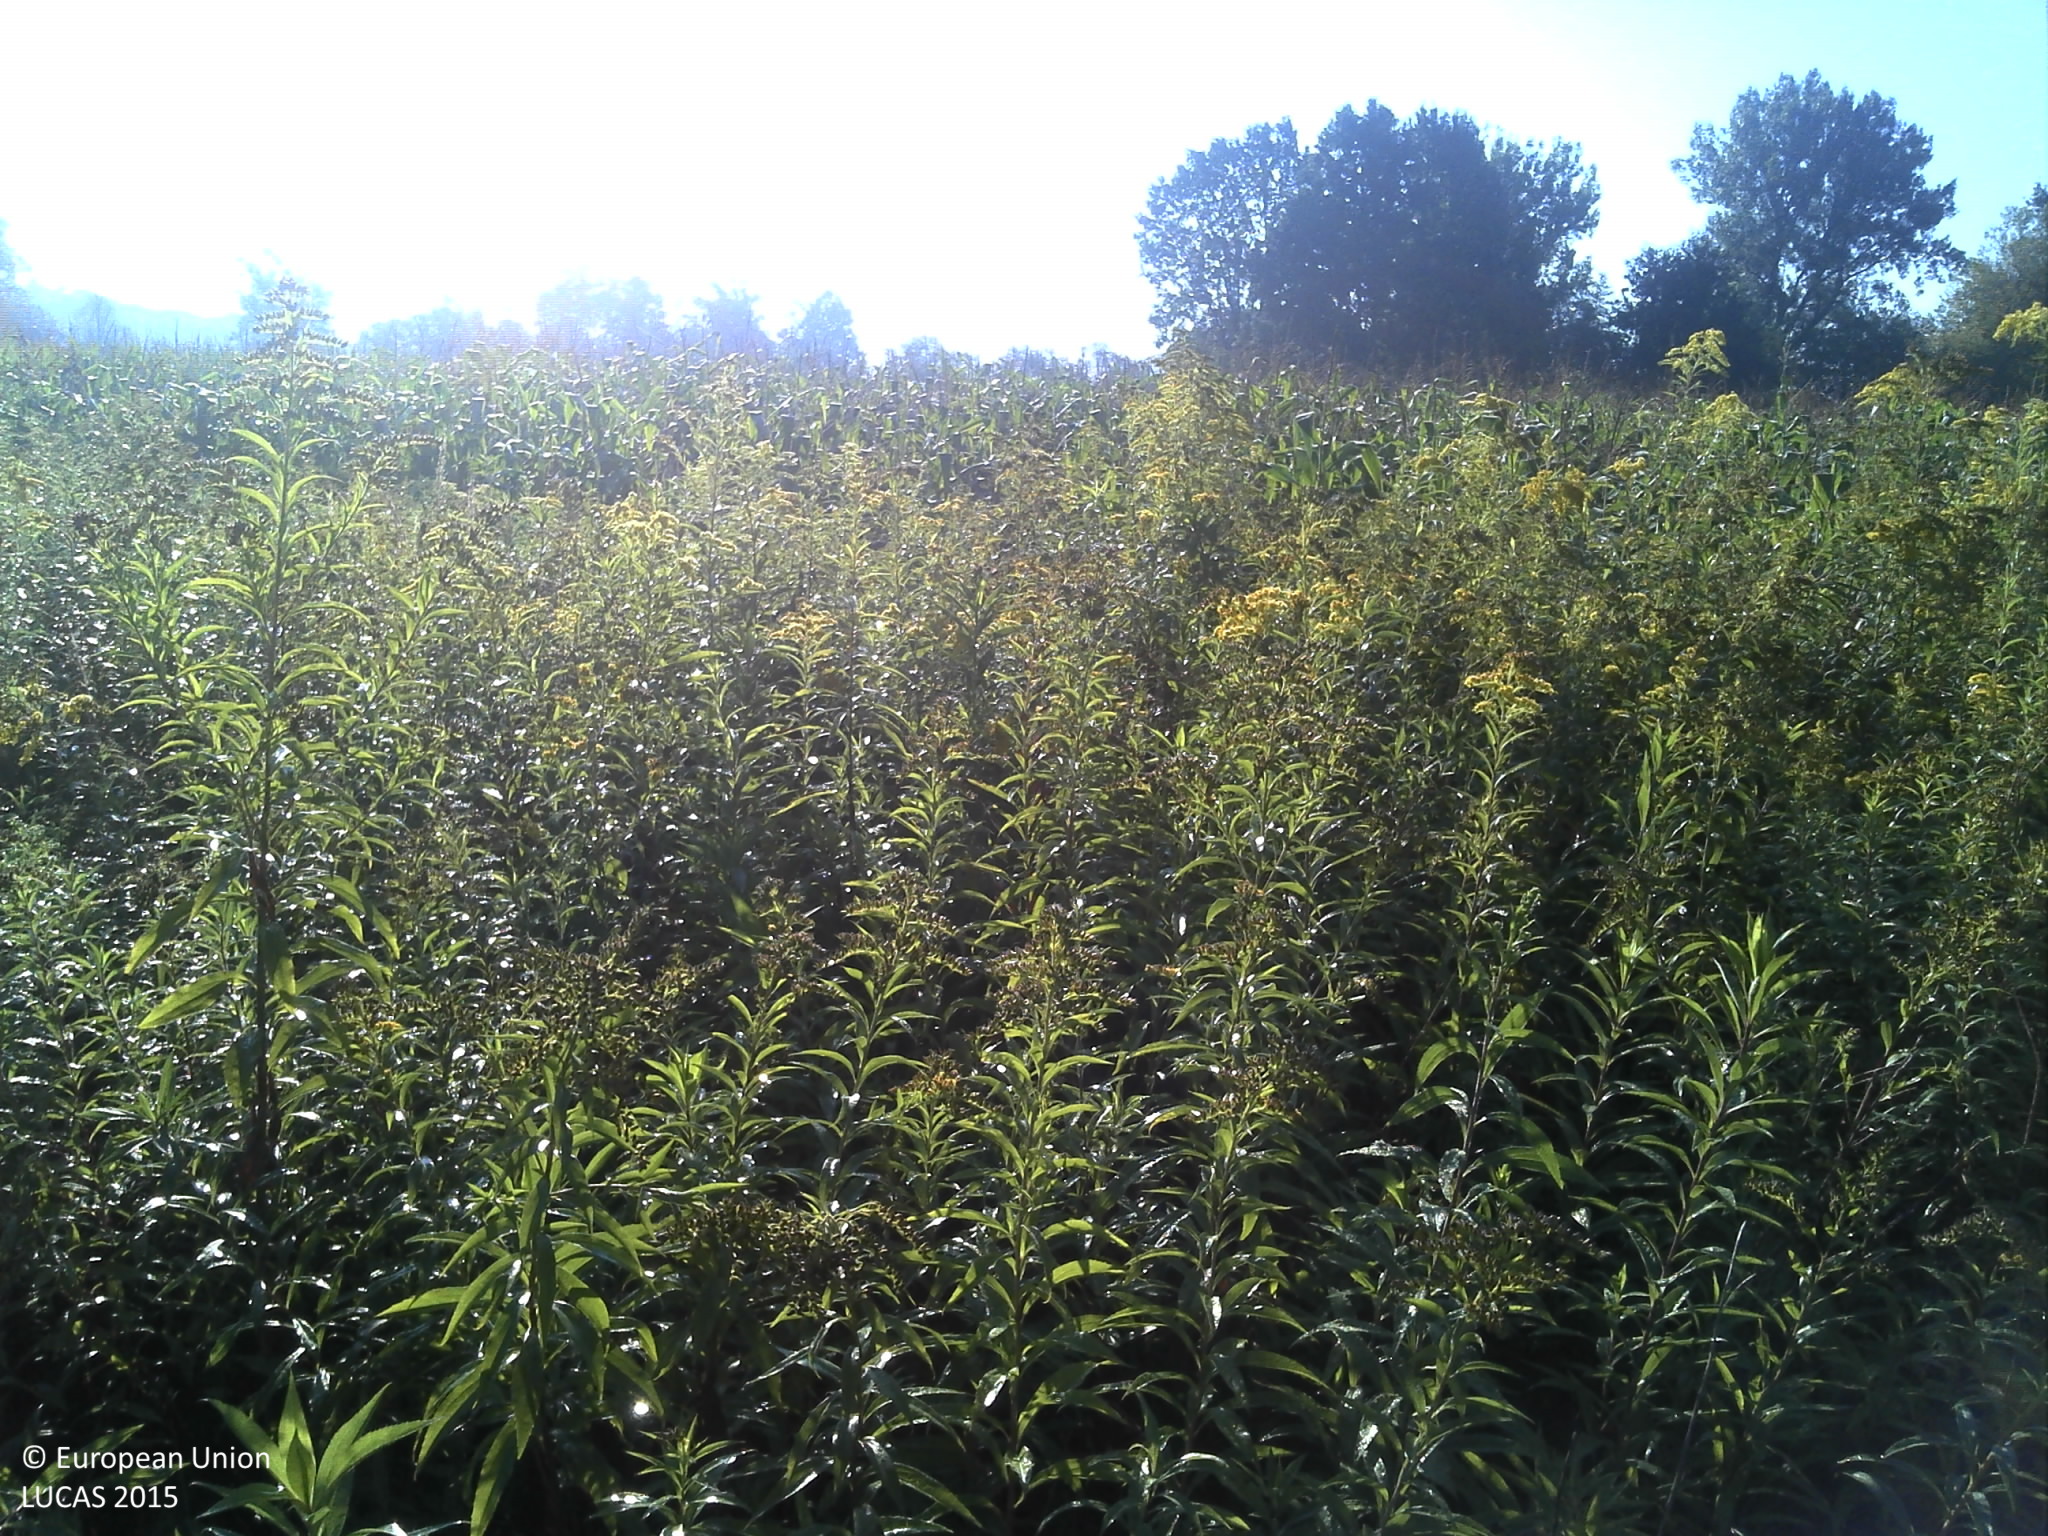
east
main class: Grassland
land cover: Spontaneously vegetated surfaces
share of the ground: > 75 %
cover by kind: herbaceous plants 100 %
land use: Fallow land
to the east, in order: Spontaneously vegetated surfaces; Maize; Tracks; Spontaneously vegetated surfaces; Broadleaved woodland
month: August
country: HR
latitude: 45.3275
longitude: 16.1082
